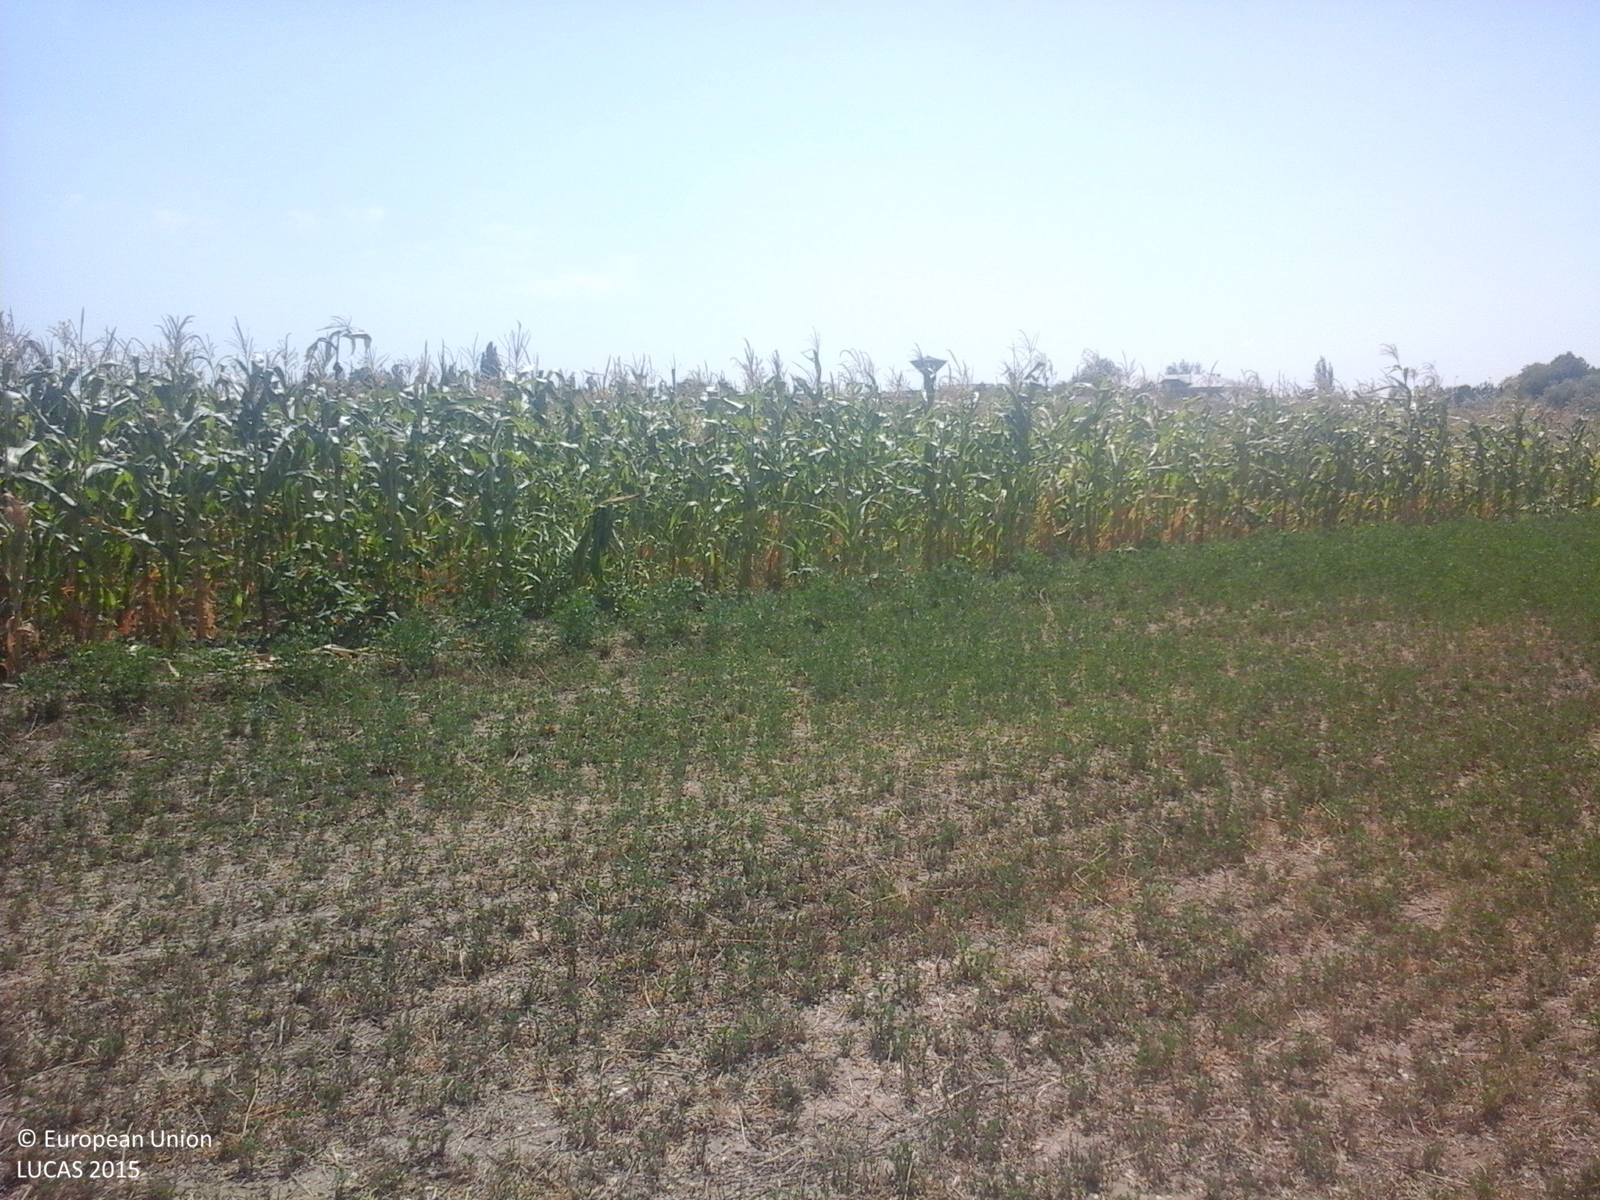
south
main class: Cropland
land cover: Lucerne
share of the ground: 50 - 75 %
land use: Agriculture (excluding fallow land and kitchen gardens)
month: August
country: RO
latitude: 45.8244
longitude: 27.4417
